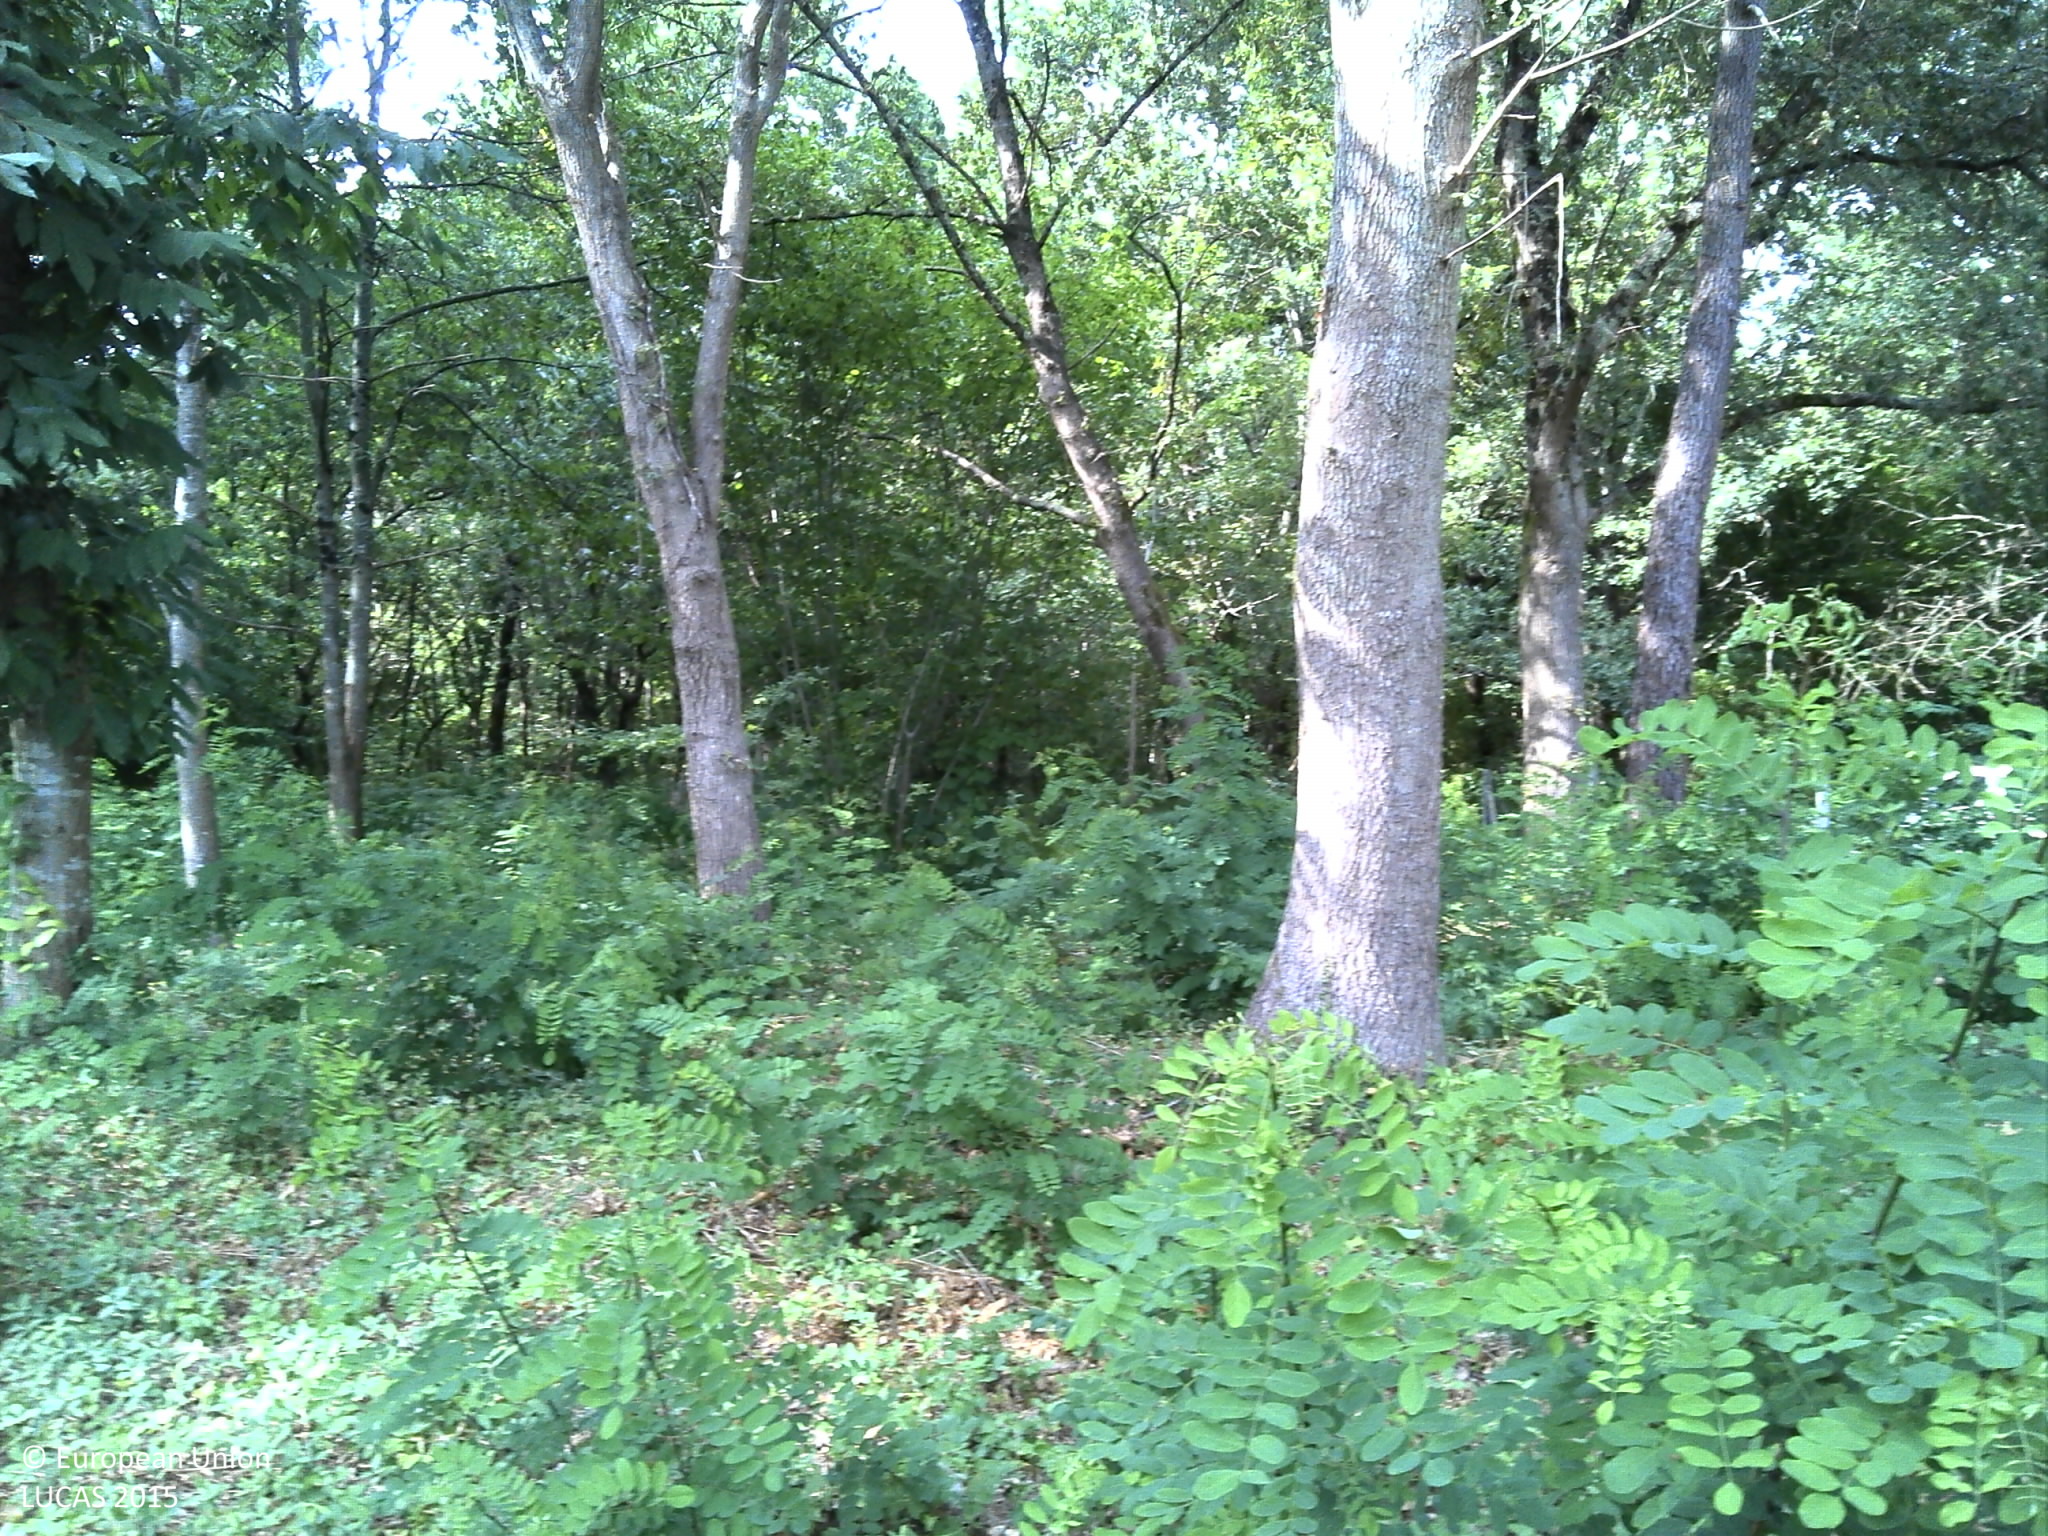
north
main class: Woodland
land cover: Broadleaved woodland
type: thermophilous deciduous forest
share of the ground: > 75 %
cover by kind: broadleaved forest trees 40 %, herbaceous plants 40 %, shrubs 20 %
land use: Semi-natural and natural areas not in use
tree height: > 5 m
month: August
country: FR
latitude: 45.0551
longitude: -0.4693
